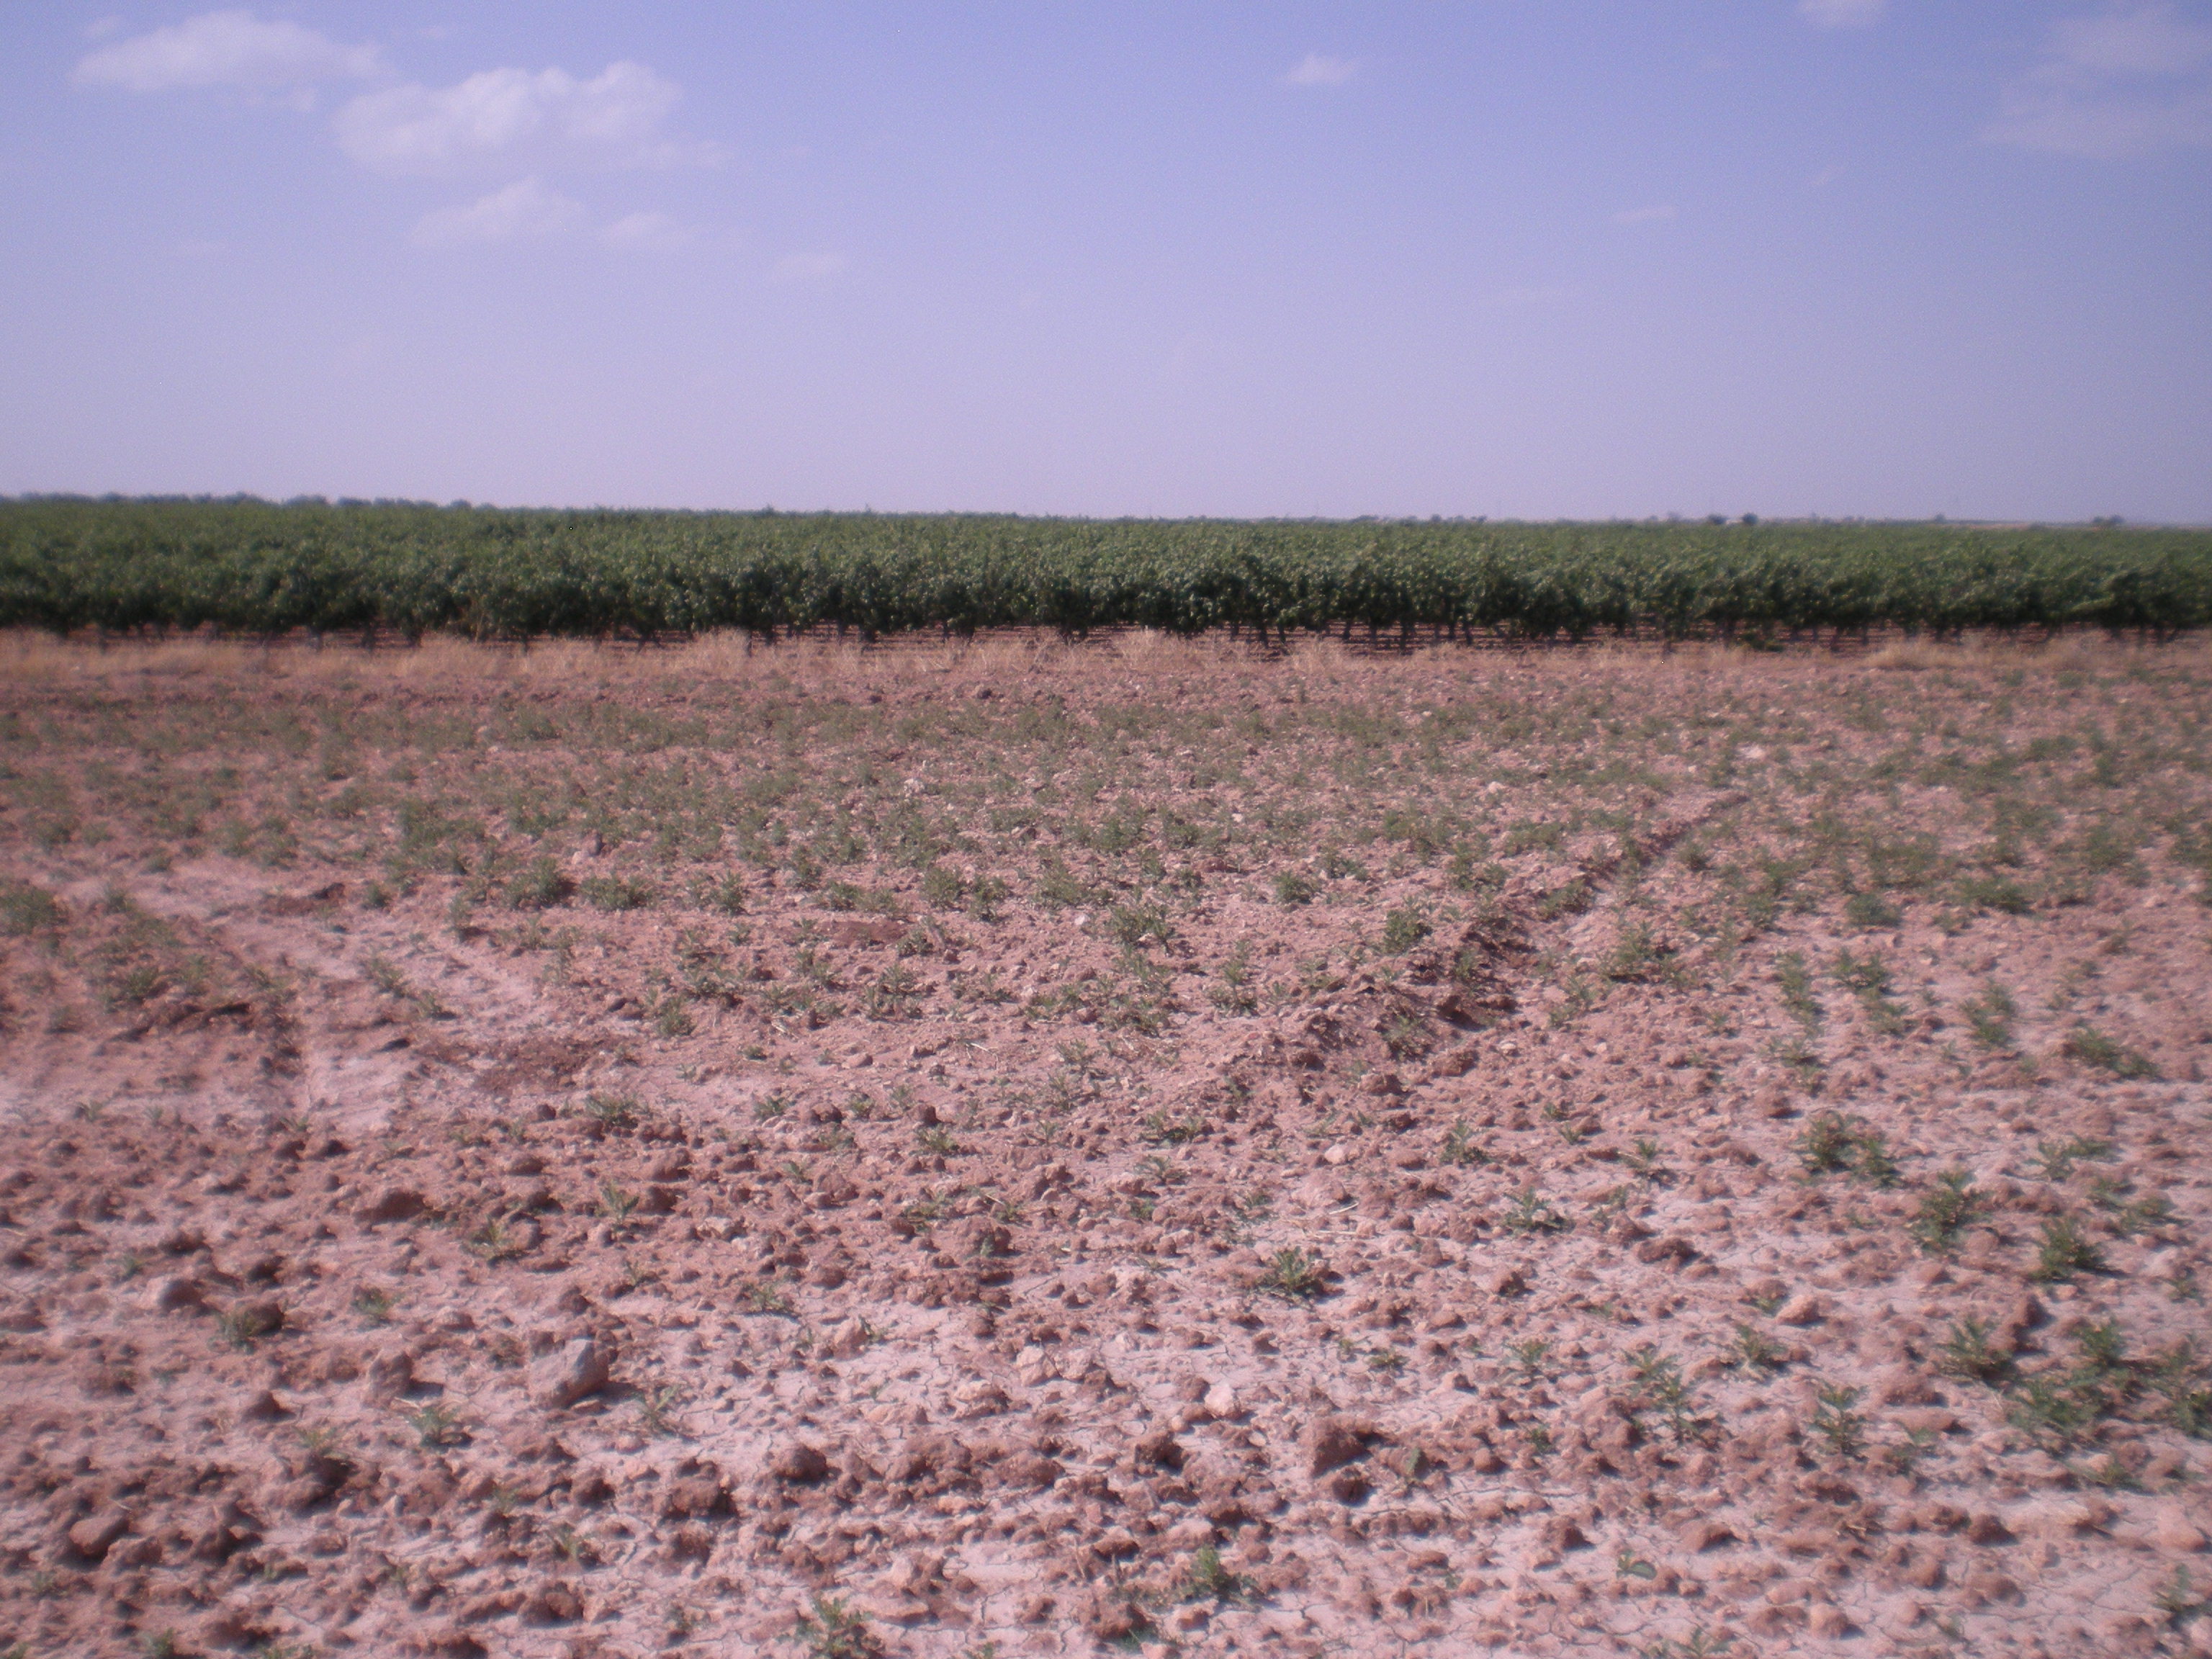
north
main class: Grassland
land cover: Spontaneously vegetated surfaces
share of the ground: 10 - 25 %
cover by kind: unconsolidated bare surface 80 %, herbaceous plants 20 %
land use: Fallow land
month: June
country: ES
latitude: 39.5555
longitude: -3.3239
